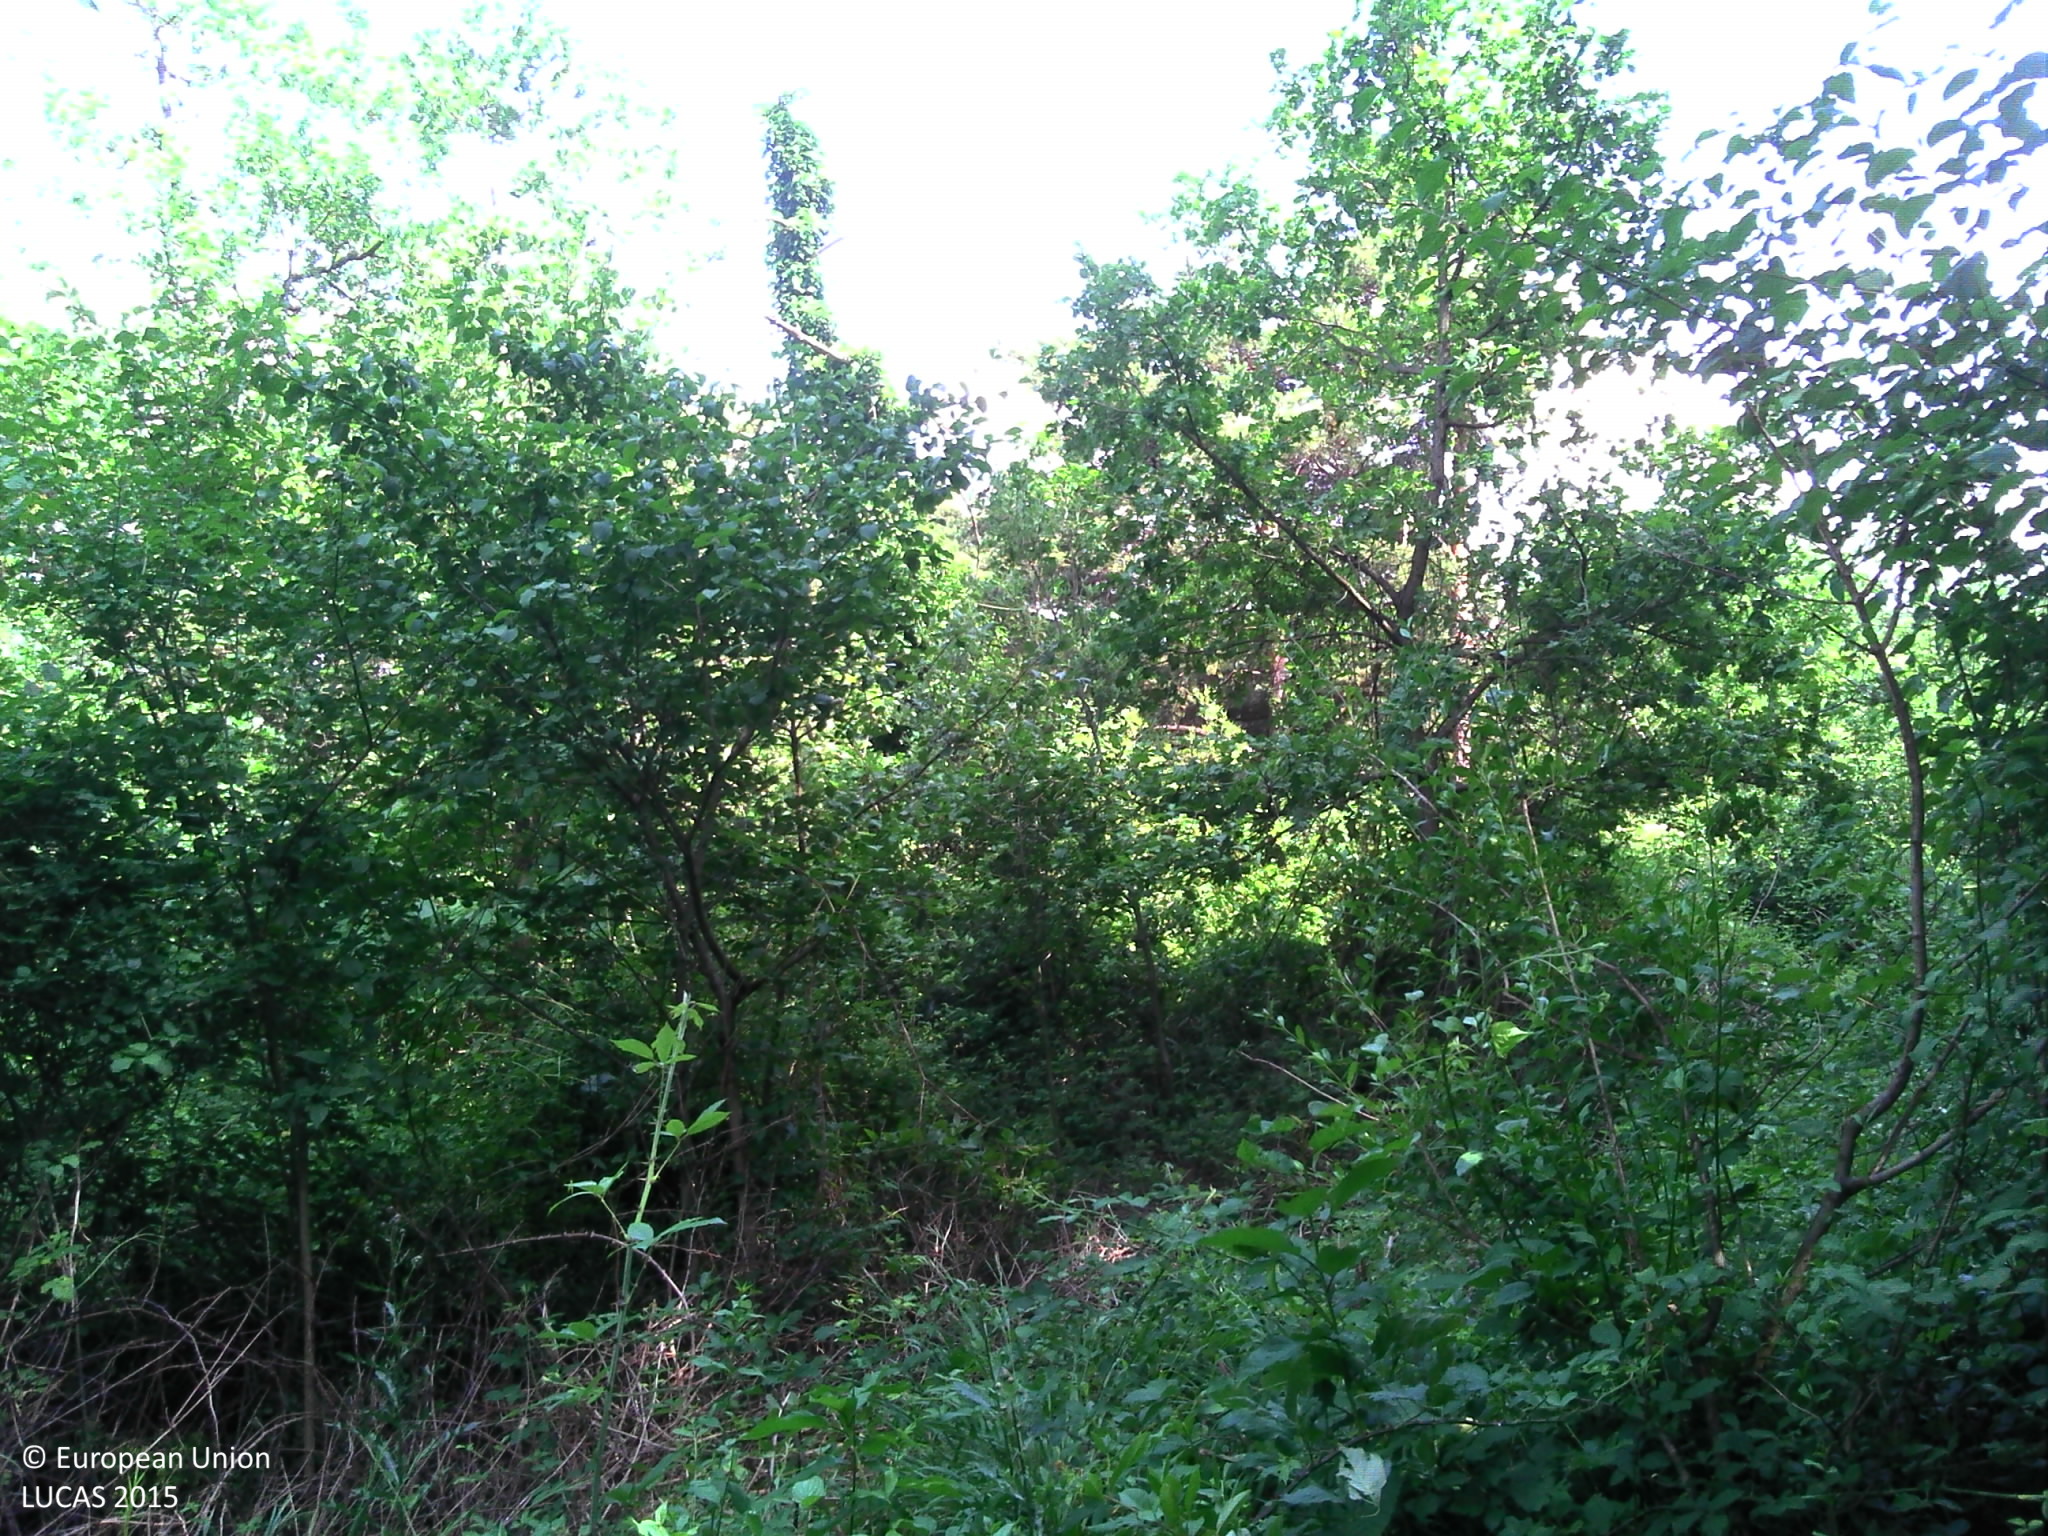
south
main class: Grassland
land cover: Grassland with sparse tree/shrub cover
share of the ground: > 75 %
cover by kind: herbaceous plants 90 %, broadleaved forest trees 5 %, shrubs 5 %
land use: Residential
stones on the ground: 25 - 50 %
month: June
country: FR
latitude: 44.7151
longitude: 4.9443
